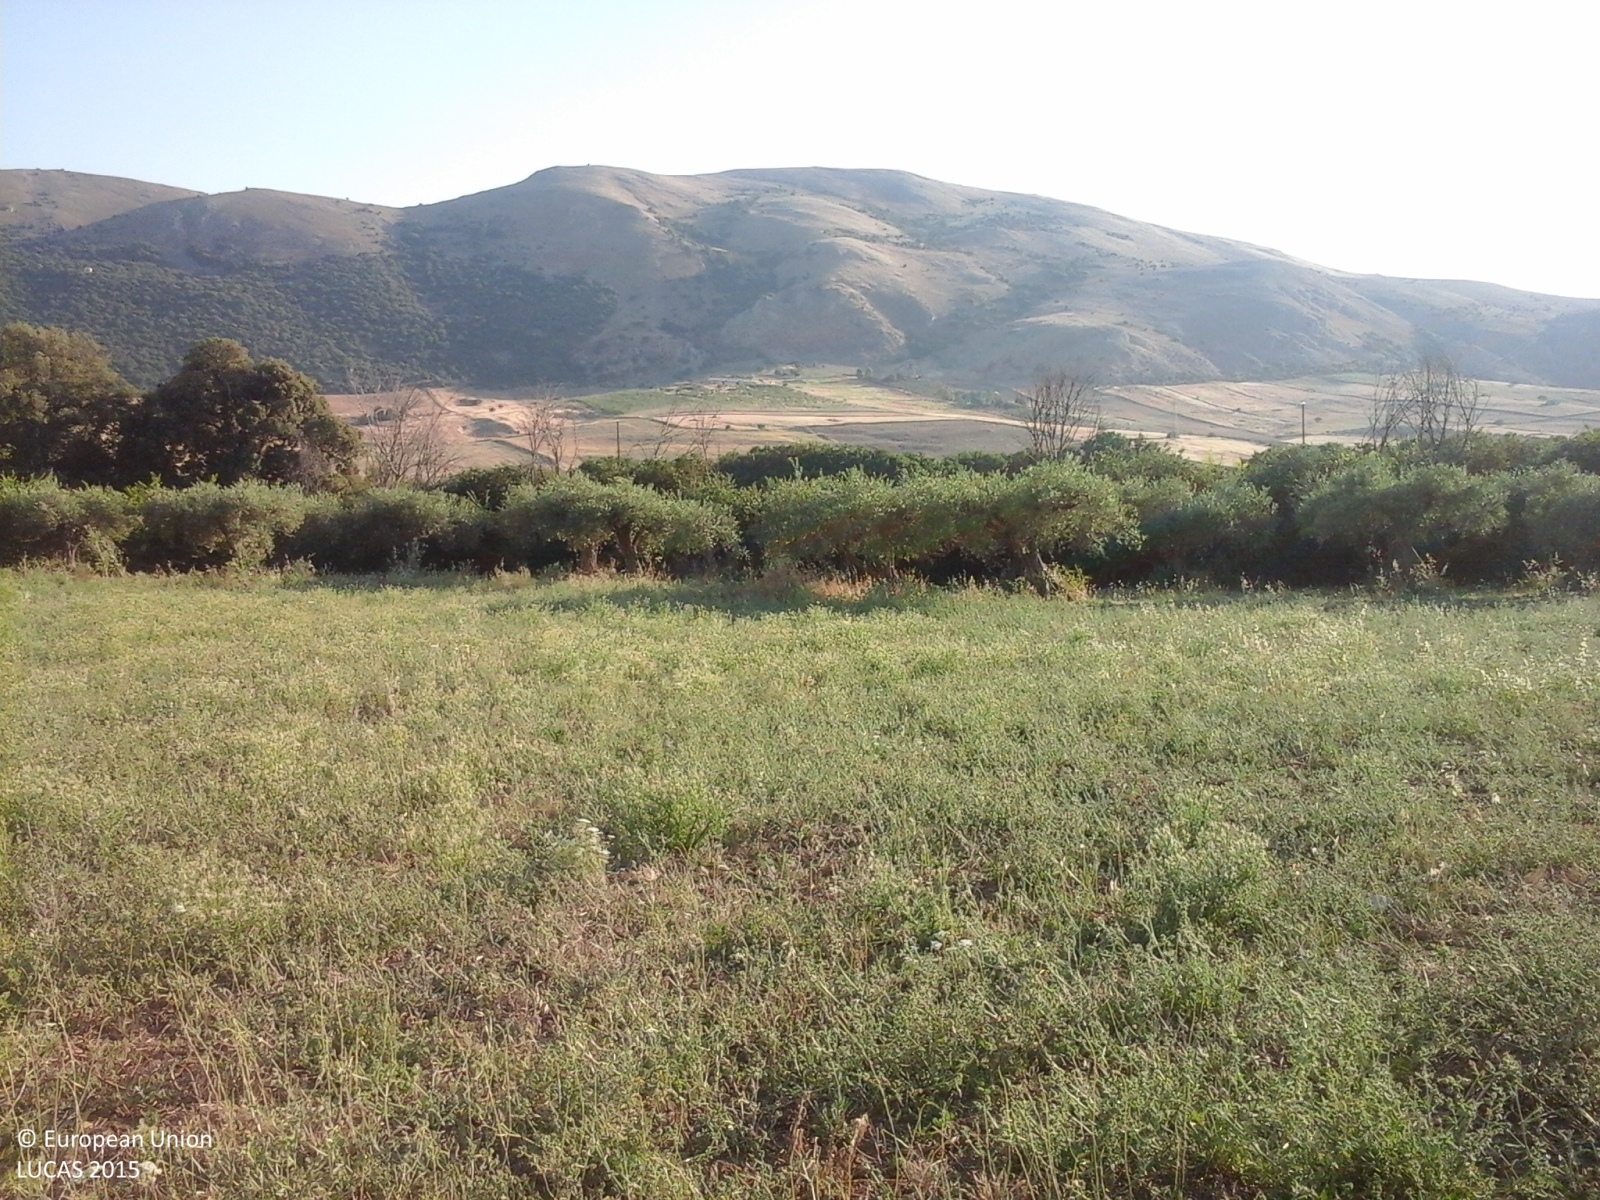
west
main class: Grassland
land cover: Spontaneously vegetated surfaces
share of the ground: > 75 %
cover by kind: herbaceous plants 100 %
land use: Agriculture (excluding fallow land and kitchen gardens)
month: July
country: IT
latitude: 37.6383
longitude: 13.2281
